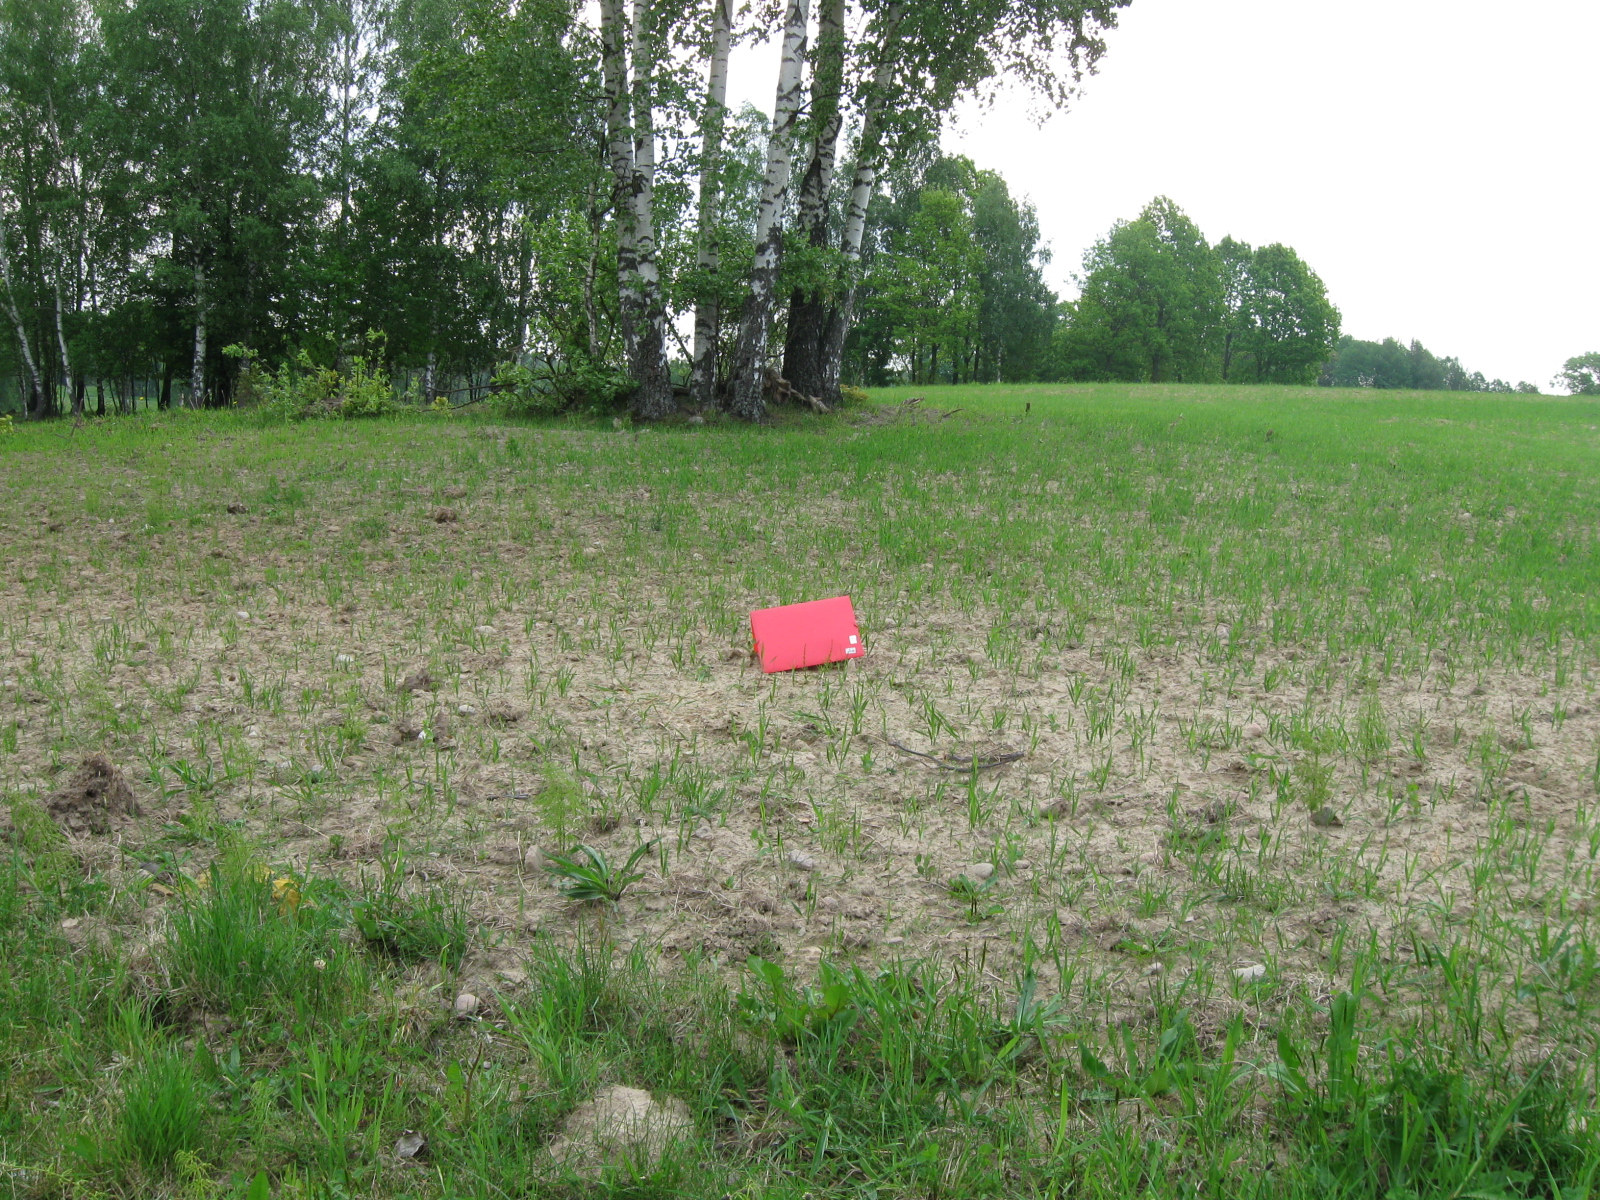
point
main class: Cropland
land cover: Oats
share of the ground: 25 - 50 %
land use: Agriculture (excluding fallow land and kitchen gardens)
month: May
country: LT
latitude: 54.4858
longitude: 22.8038
